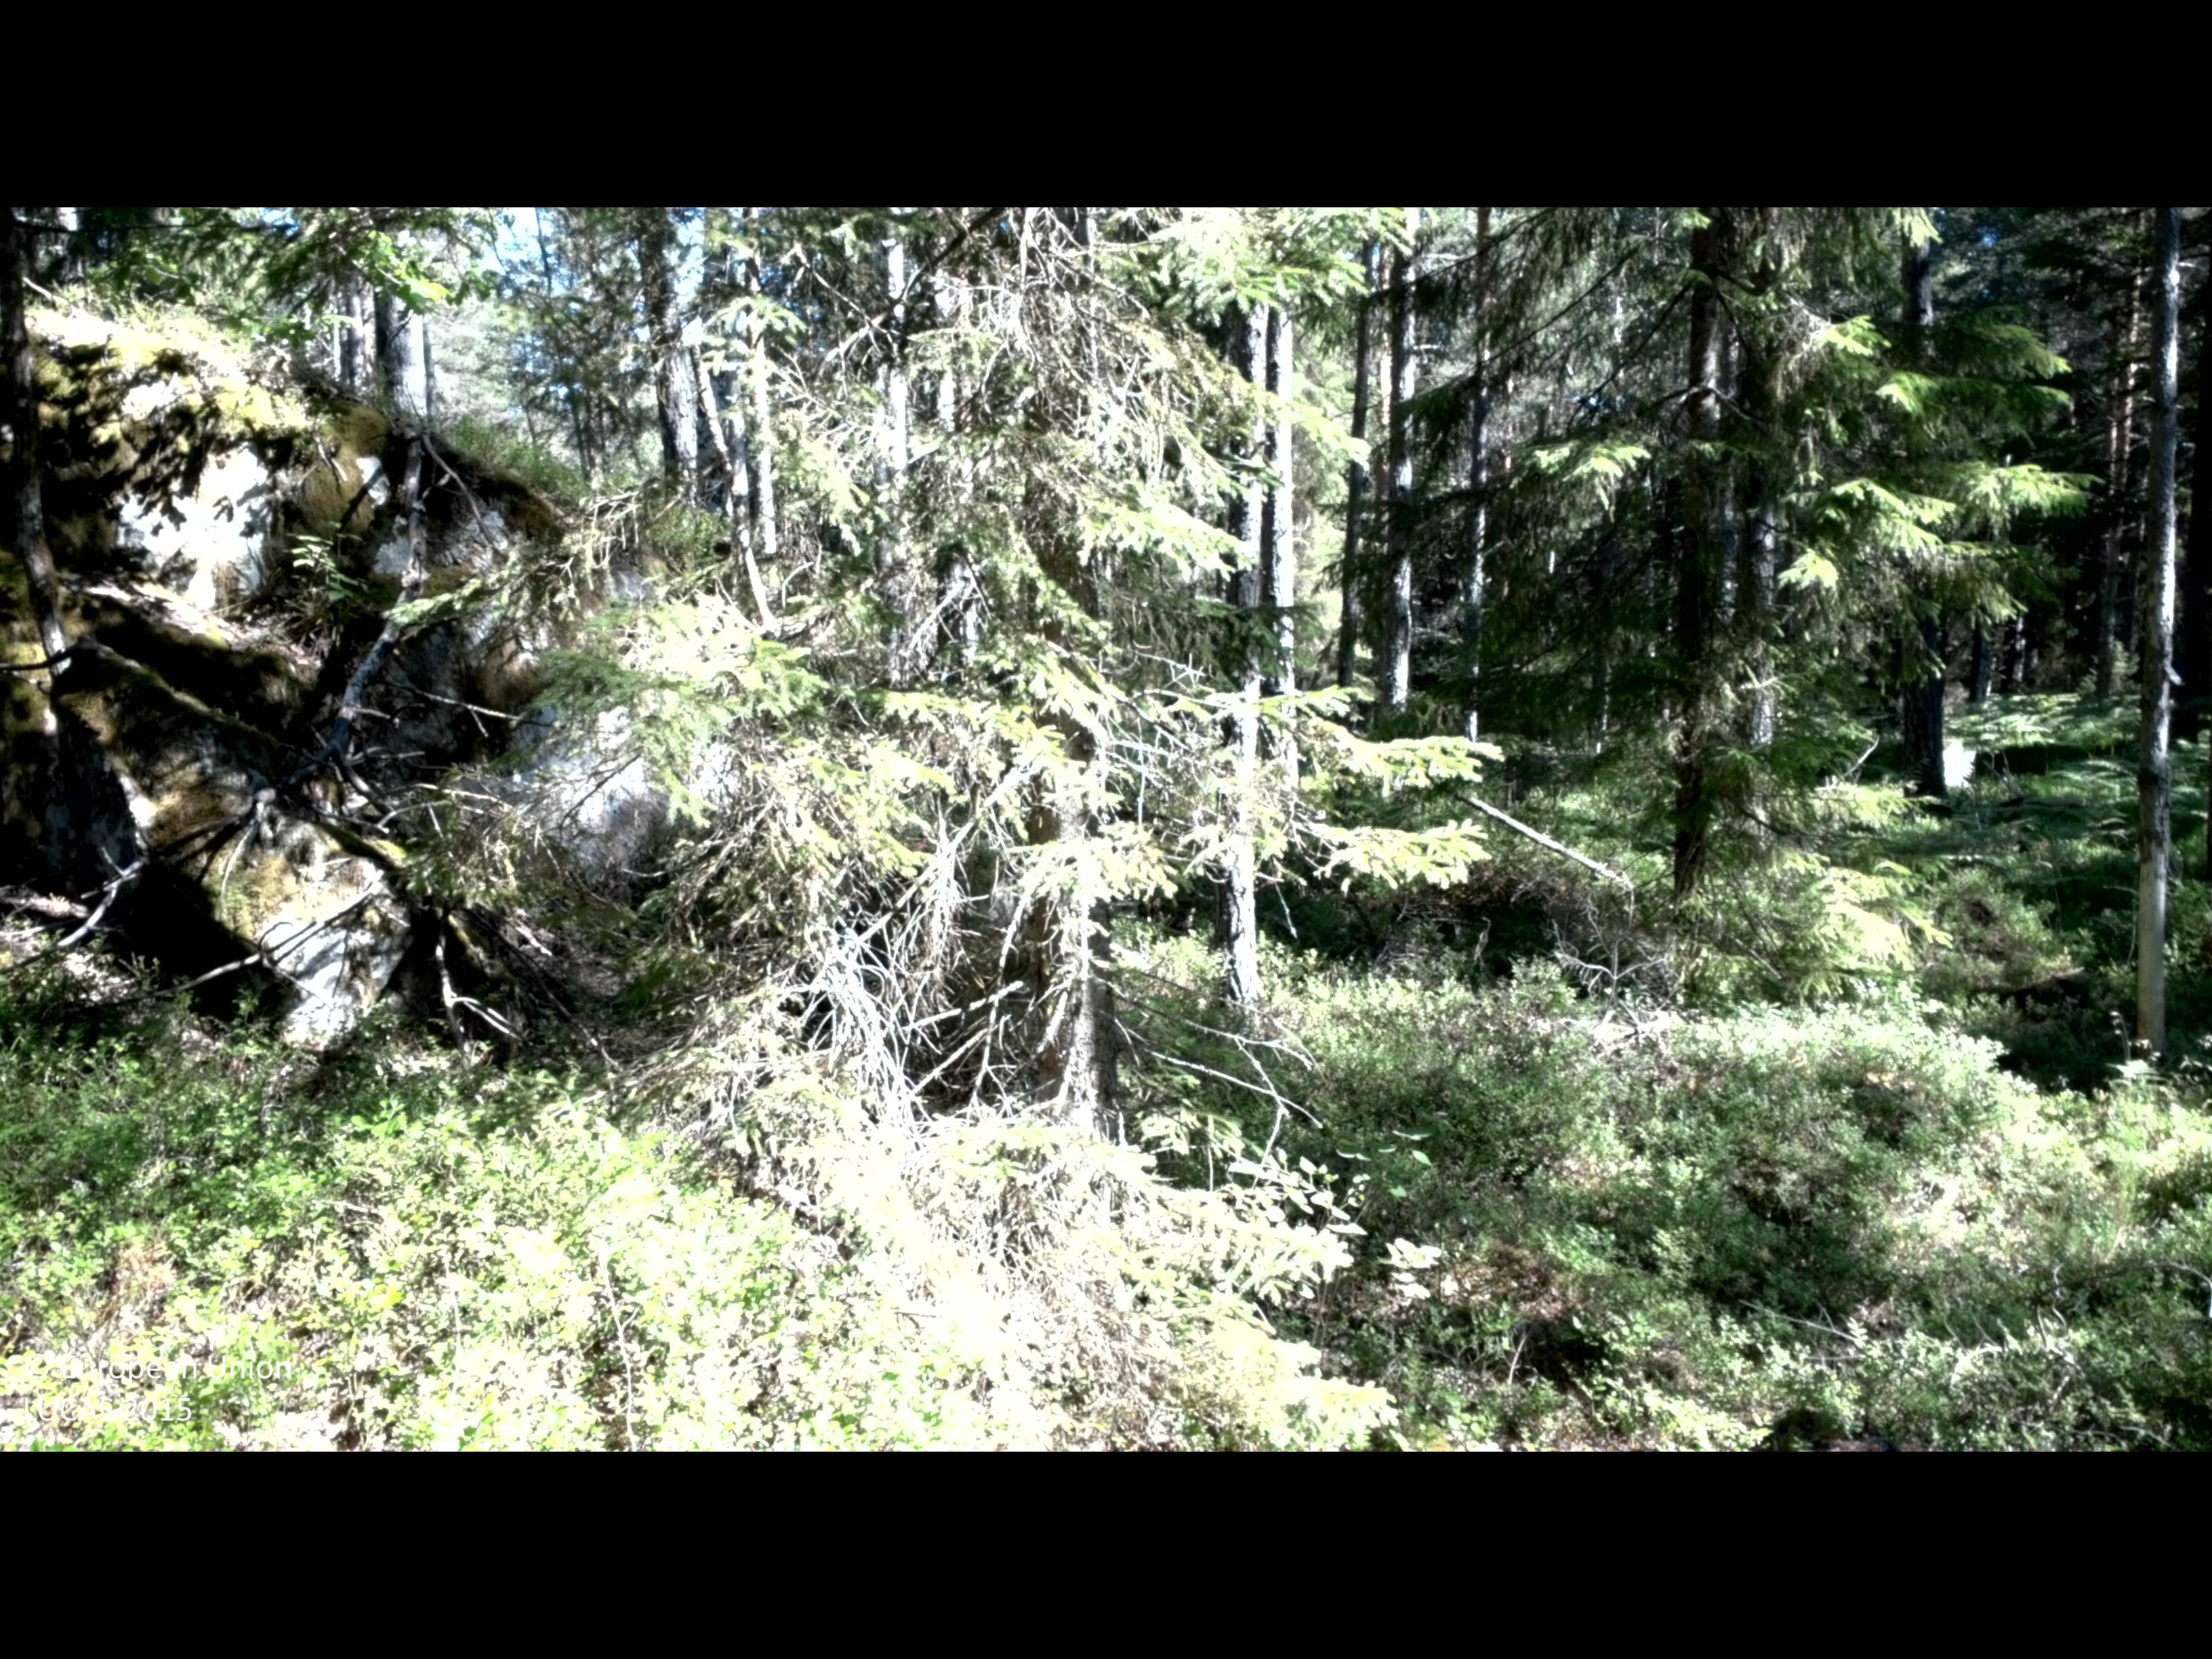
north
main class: Woodland
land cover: Other coniferous woodland
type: boreal forest
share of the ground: 50 - 75 %
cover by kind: coniferous forest trees 55 %, shrubs 25 %, broadleaved forest trees 15 %, herbaceous plants 5 %
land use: Forestry
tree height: > 5 m
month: July
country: SE
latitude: 58.2060
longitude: 16.5147
